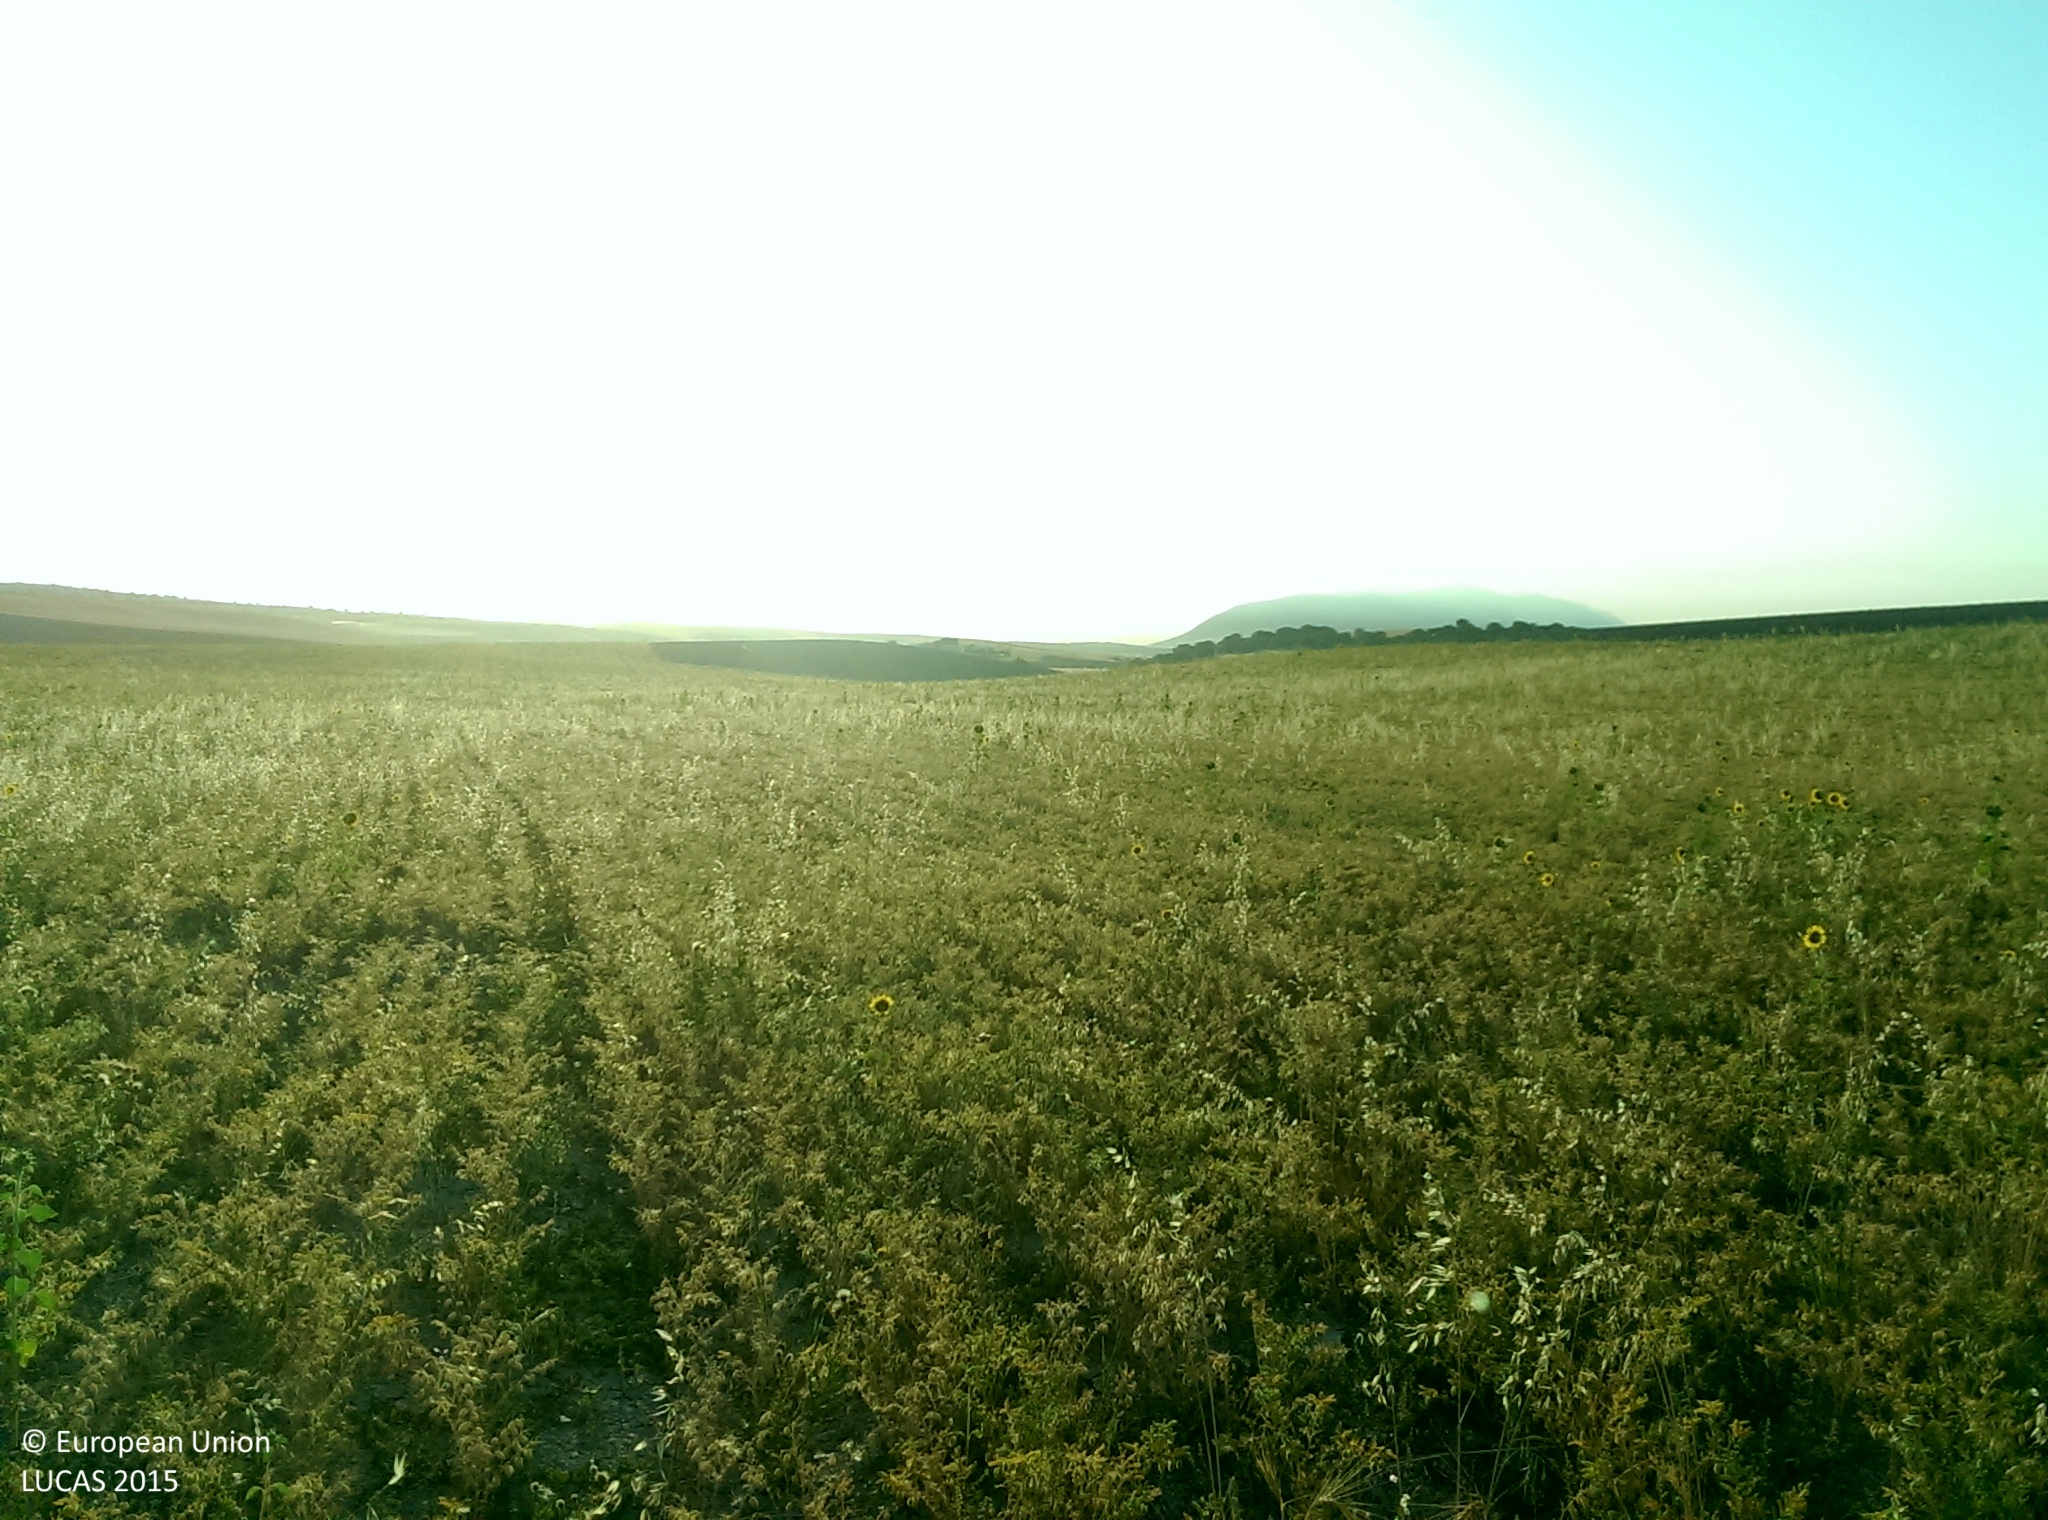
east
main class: Cropland
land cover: Dry pulses
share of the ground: > 75 %
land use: Agriculture (excluding fallow land and kitchen gardens)
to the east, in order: Dry pulses; Other bare soil
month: July
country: ES
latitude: 37.5053
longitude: -3.3063
